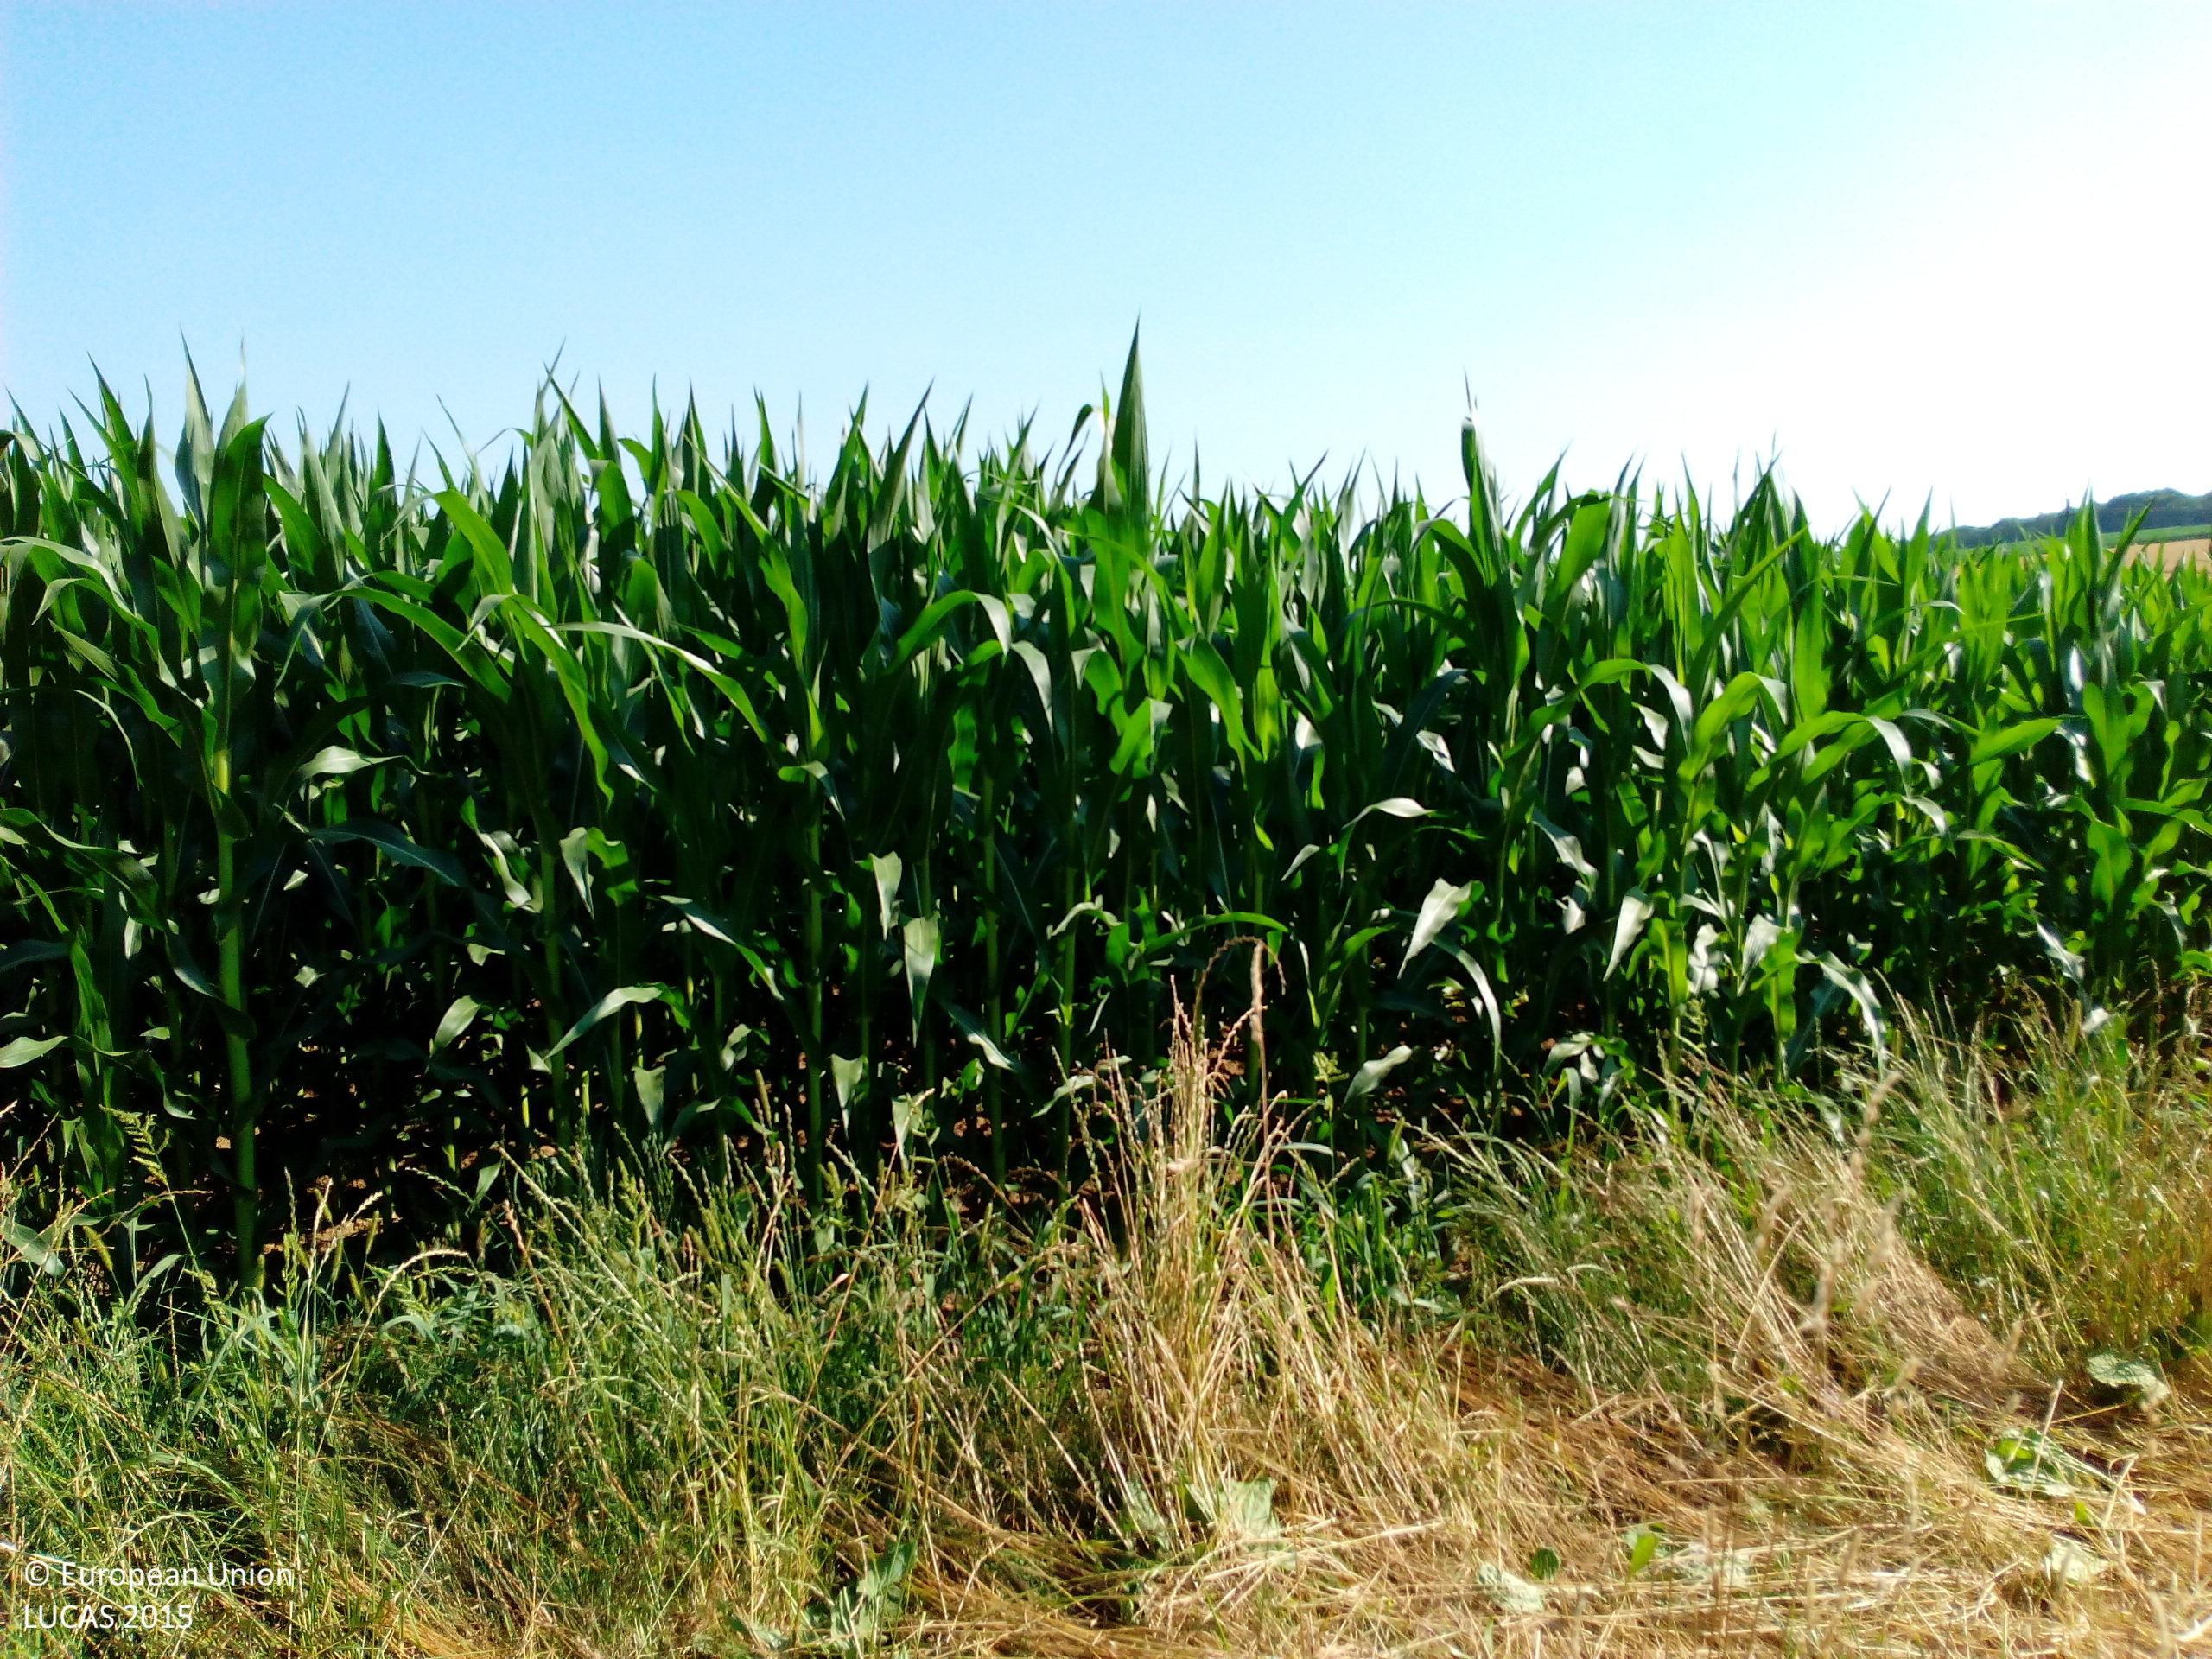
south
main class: Cropland
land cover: Maize
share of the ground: > 75 %
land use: Agriculture (excluding fallow land and kitchen gardens)
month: July
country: DE
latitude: 47.6763
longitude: 7.6439
